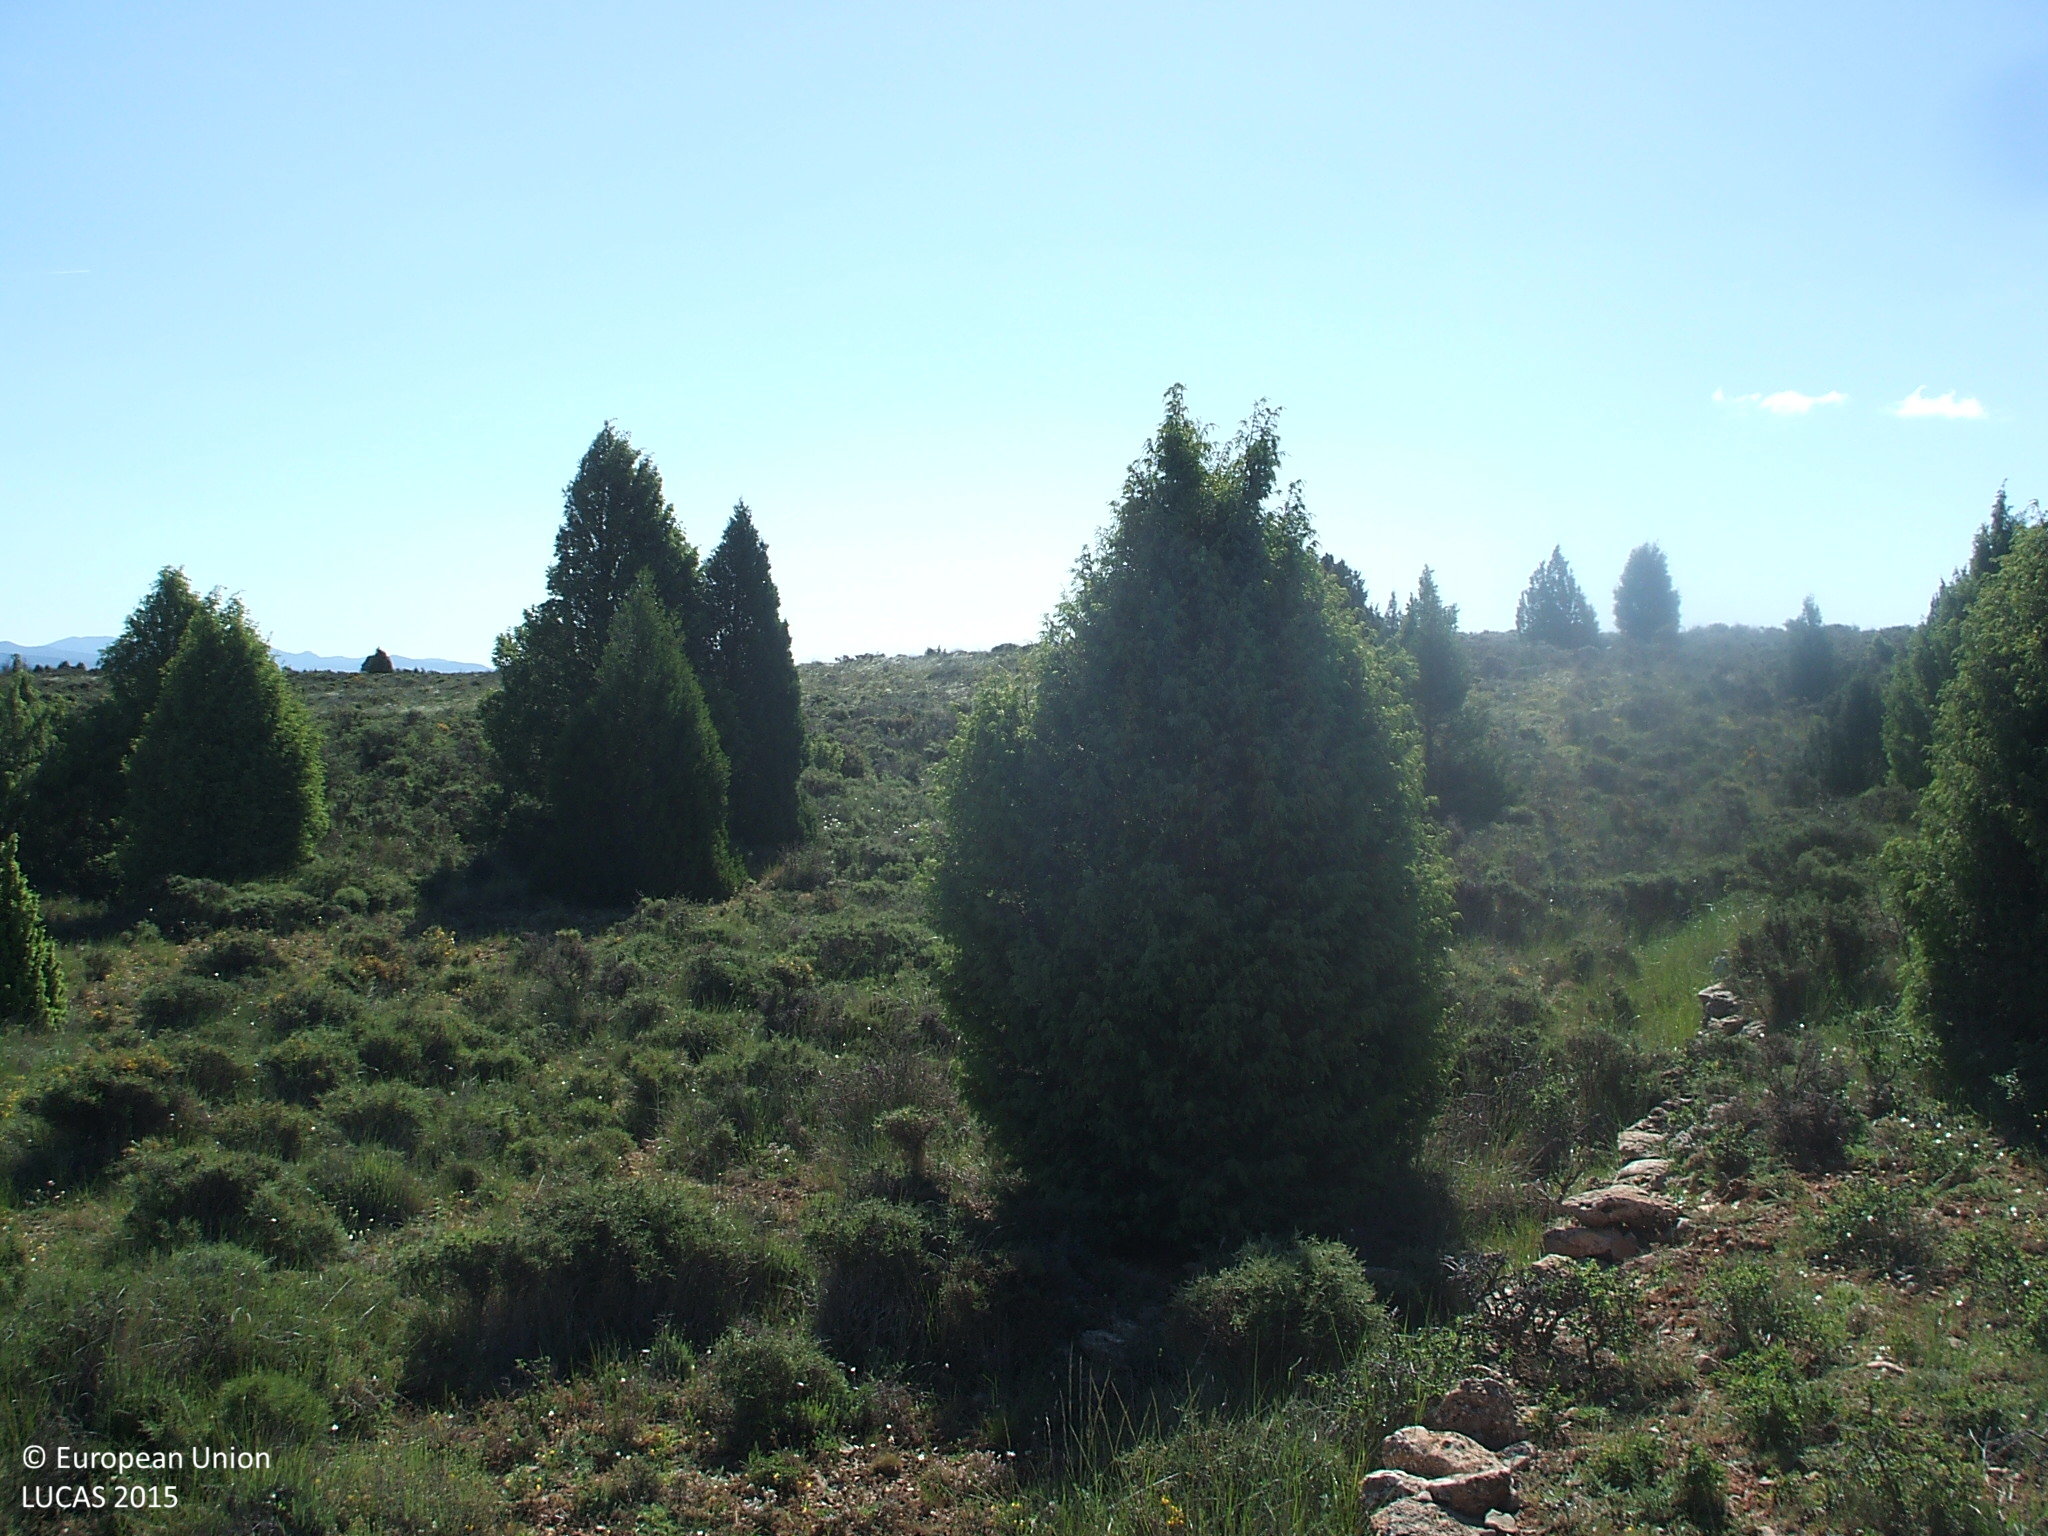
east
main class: Woodland
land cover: Other coniferous woodland
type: coniferous forest of the mediterranean region
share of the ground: 10 - 25 %
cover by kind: shrubs 45 %, unconsolidated bare surface 25 %, coniferous forest trees 20 %, herbaceous plants 10 %
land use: Semi-natural and natural areas not in use
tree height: < 5 m
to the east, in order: Other coniferous woodland; Shrubland with sparse tree cover; Shrubland without tree cover; Rivers and streams; Shrubland without tree cover; Dry stone walls; Shrubland without tree cover
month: May
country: ES
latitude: 40.1084
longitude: -0.7877
